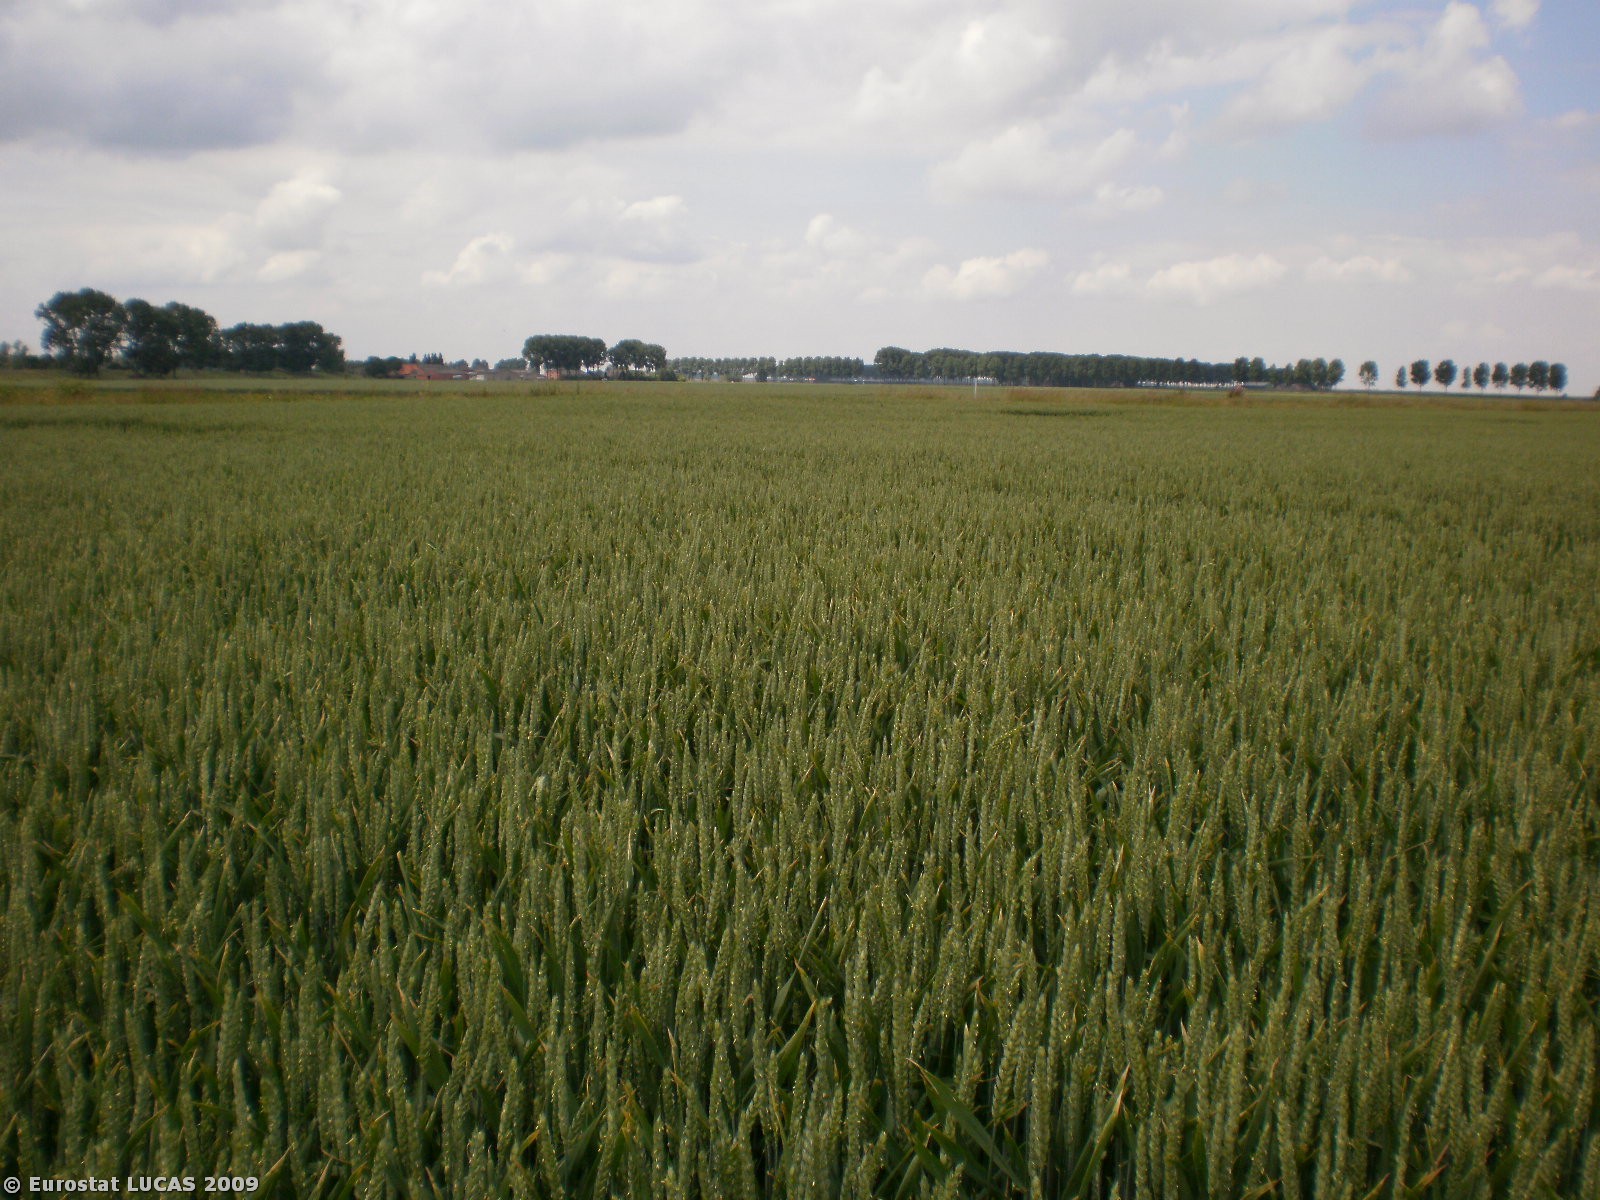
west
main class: Cropland
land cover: Common wheat
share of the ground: > 75 %
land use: Agriculture (excluding fallow land and kitchen gardens)
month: June
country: BE
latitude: 51.3172
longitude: 4.2126
